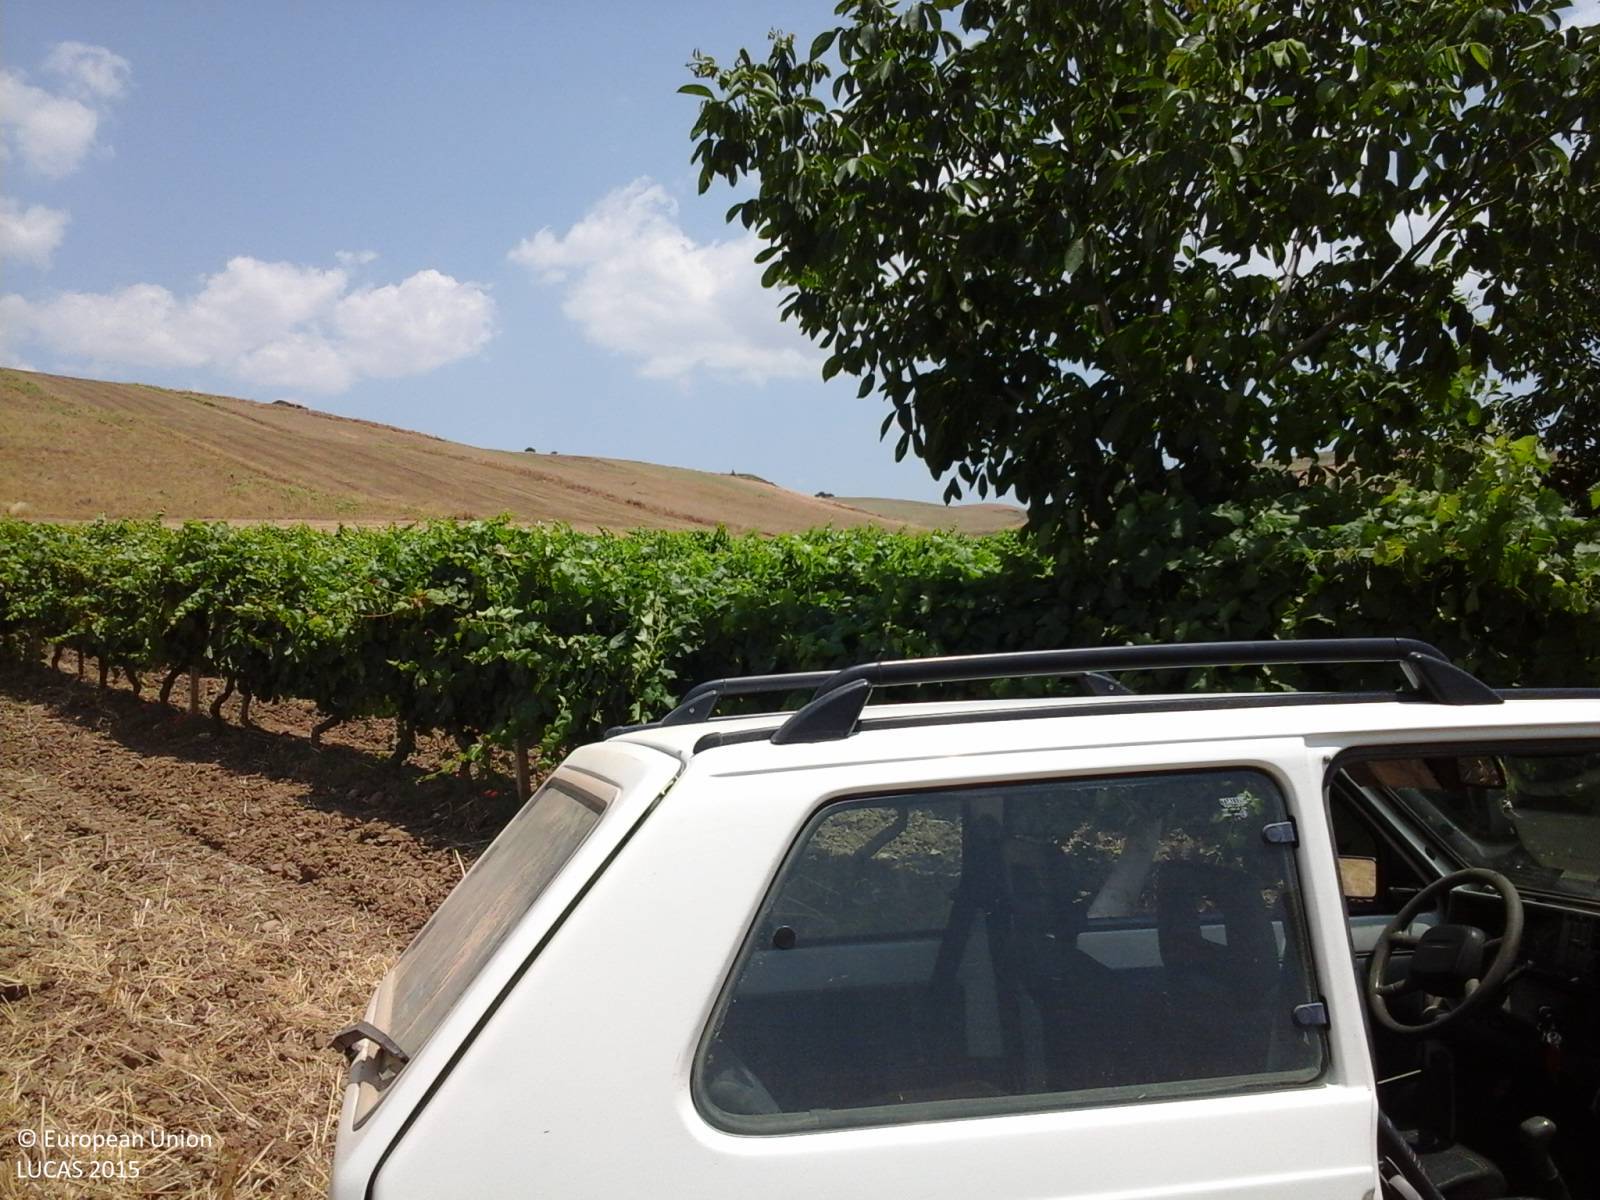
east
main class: Cropland
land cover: Durum wheat
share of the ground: > 75 %
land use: Agriculture (excluding fallow land and kitchen gardens)
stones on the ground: < 10 %
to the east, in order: Durum wheat; Vineyards; Durum wheat
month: July
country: IT
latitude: 37.8015
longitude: 13.2358
